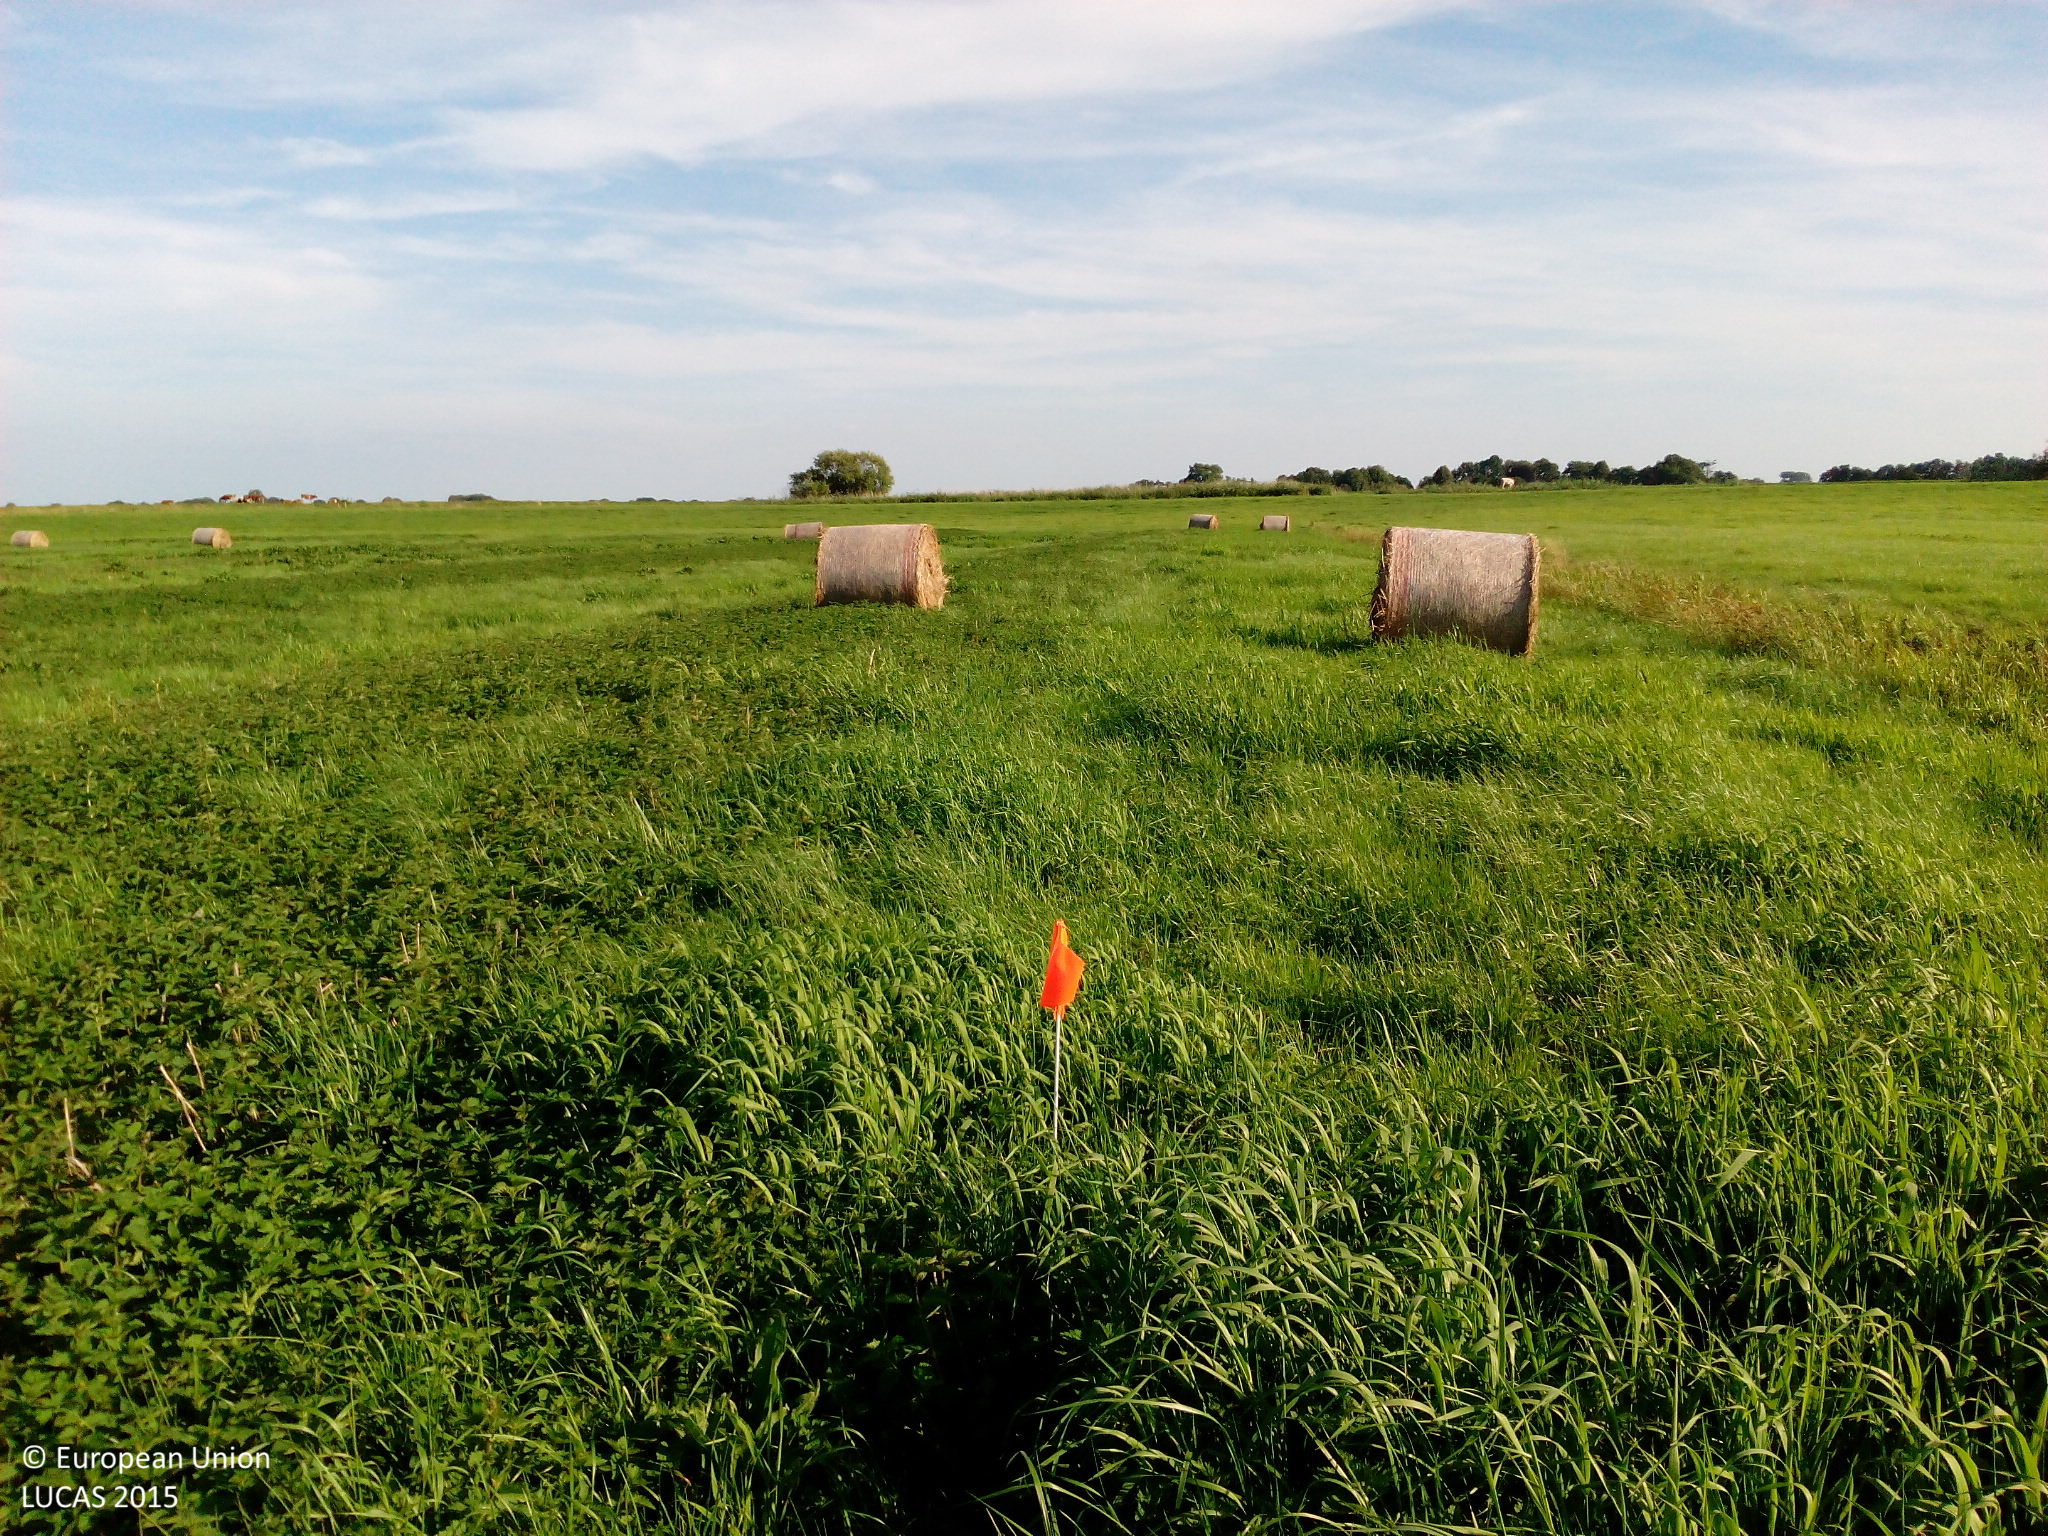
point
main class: Grassland
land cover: Grassland without tree/shrub cover
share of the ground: > 75 %
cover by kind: herbaceous plants 100 %
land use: Agriculture (excluding fallow land and kitchen gardens)
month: August
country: DE
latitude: 53.9406
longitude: 9.6498
